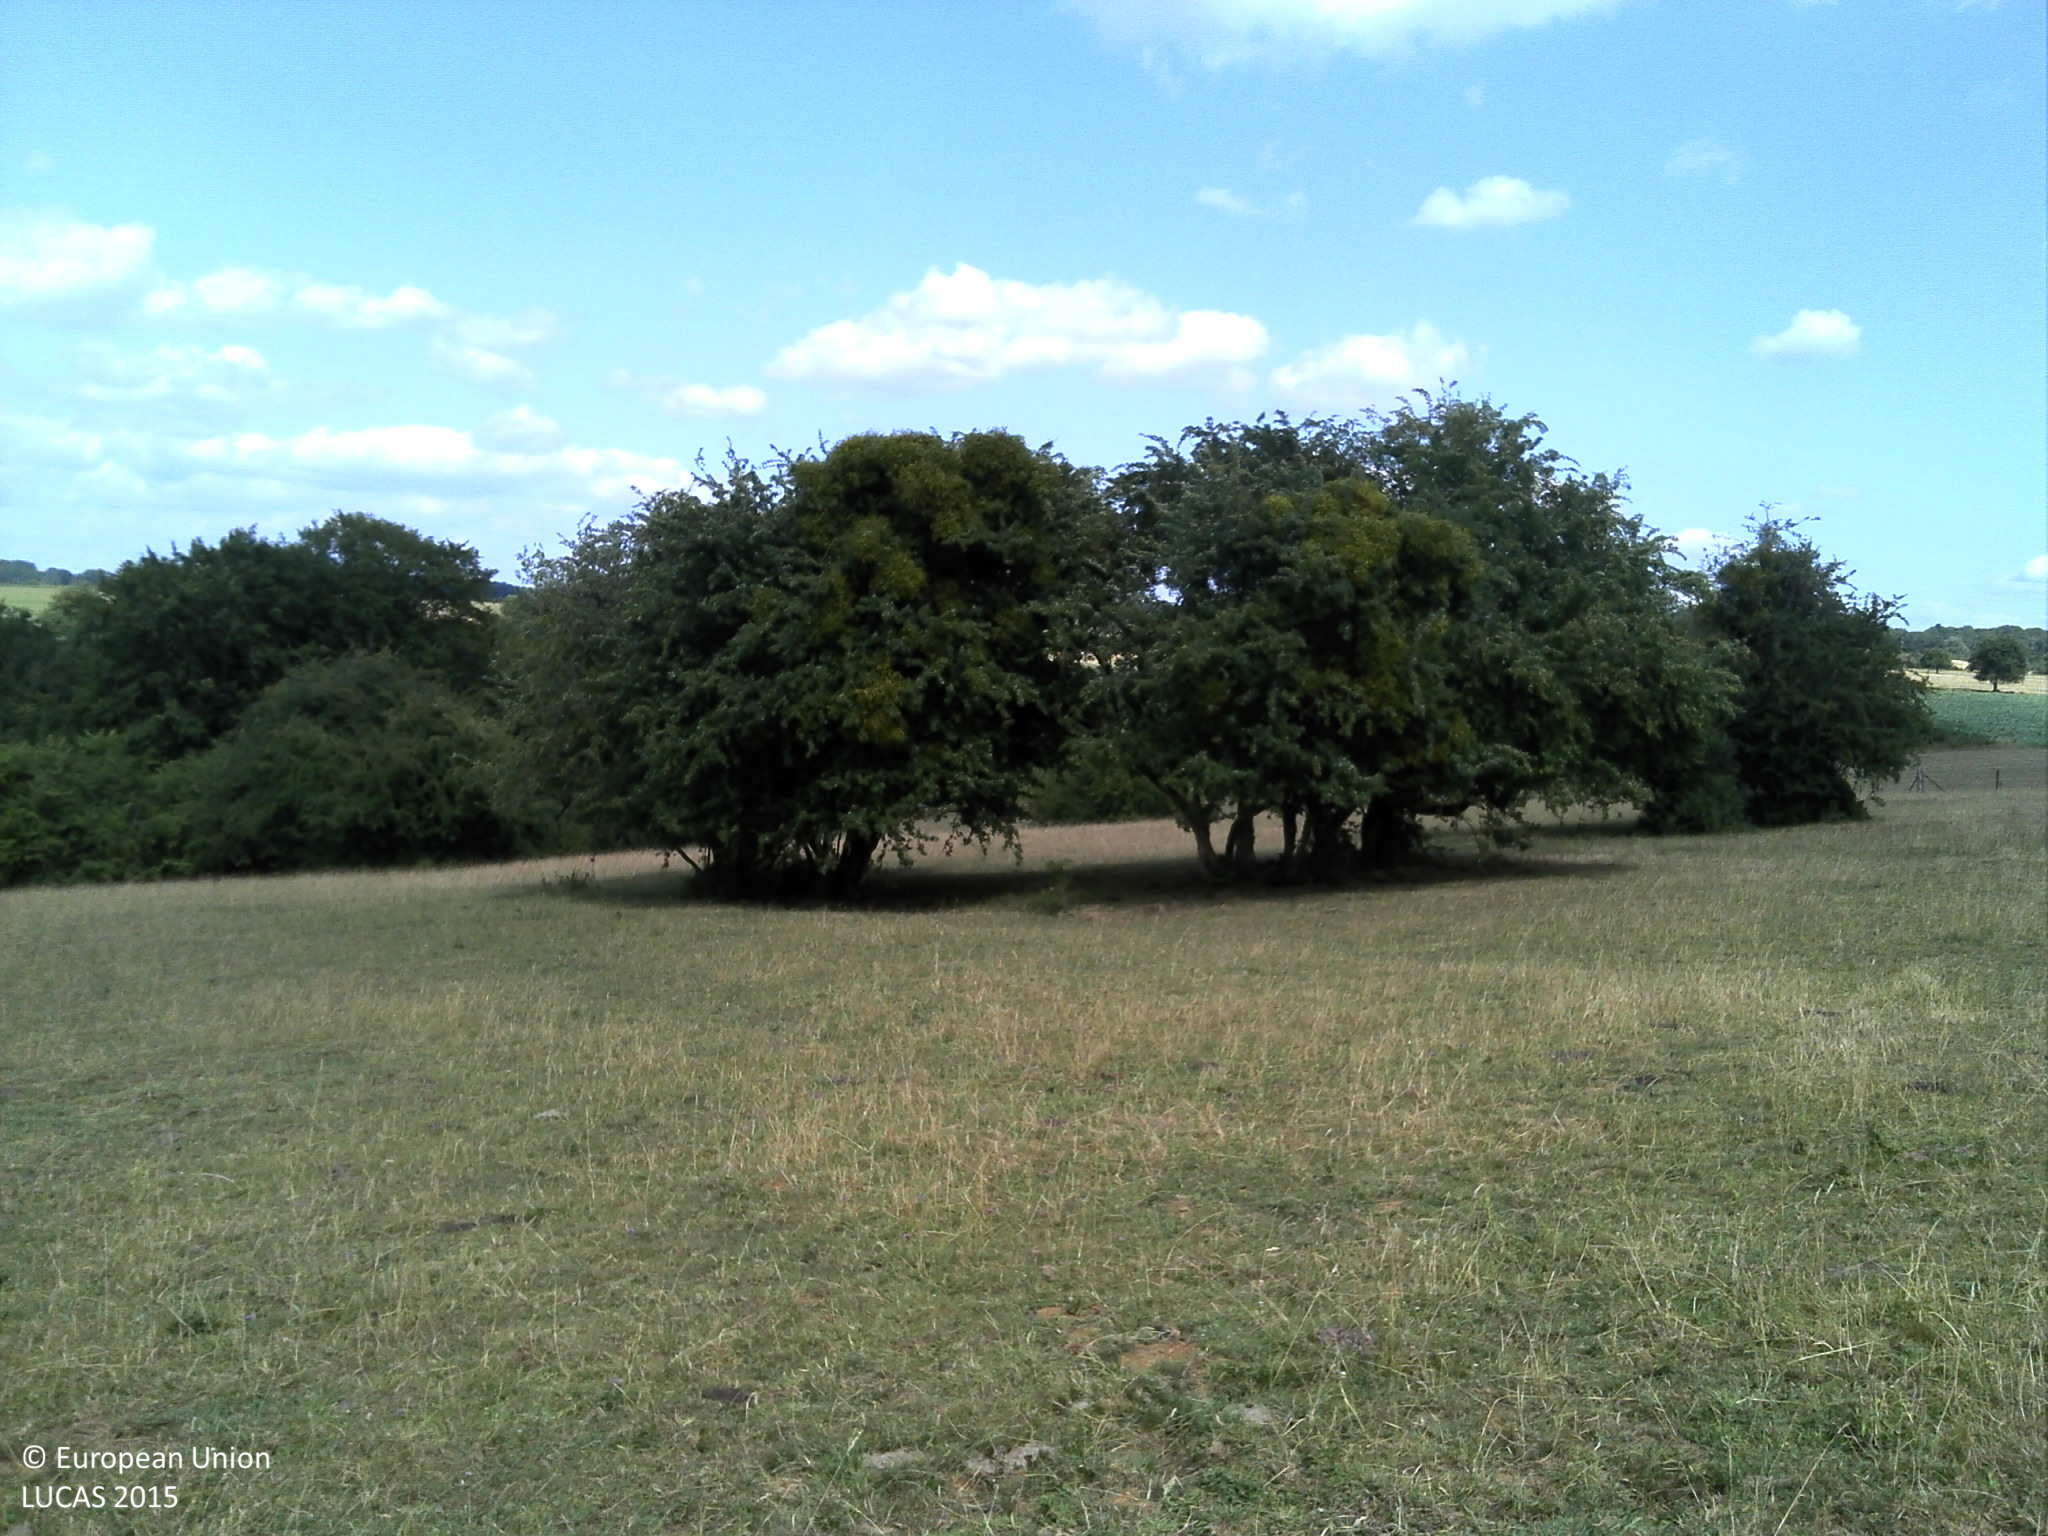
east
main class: Grassland
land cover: Grassland without tree/shrub cover
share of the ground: > 75 %
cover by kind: herbaceous plants 100 %
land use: Agriculture (excluding fallow land and kitchen gardens)
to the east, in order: Grassland without tree/shrub cover; Grassland with sparse tree/shrub cover; Grassland without tree/shrub cover; Fences; Grassland without tree/shrub cover; Fences; Temporary grasslands
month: July
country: FR
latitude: 49.6448
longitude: 4.6647
